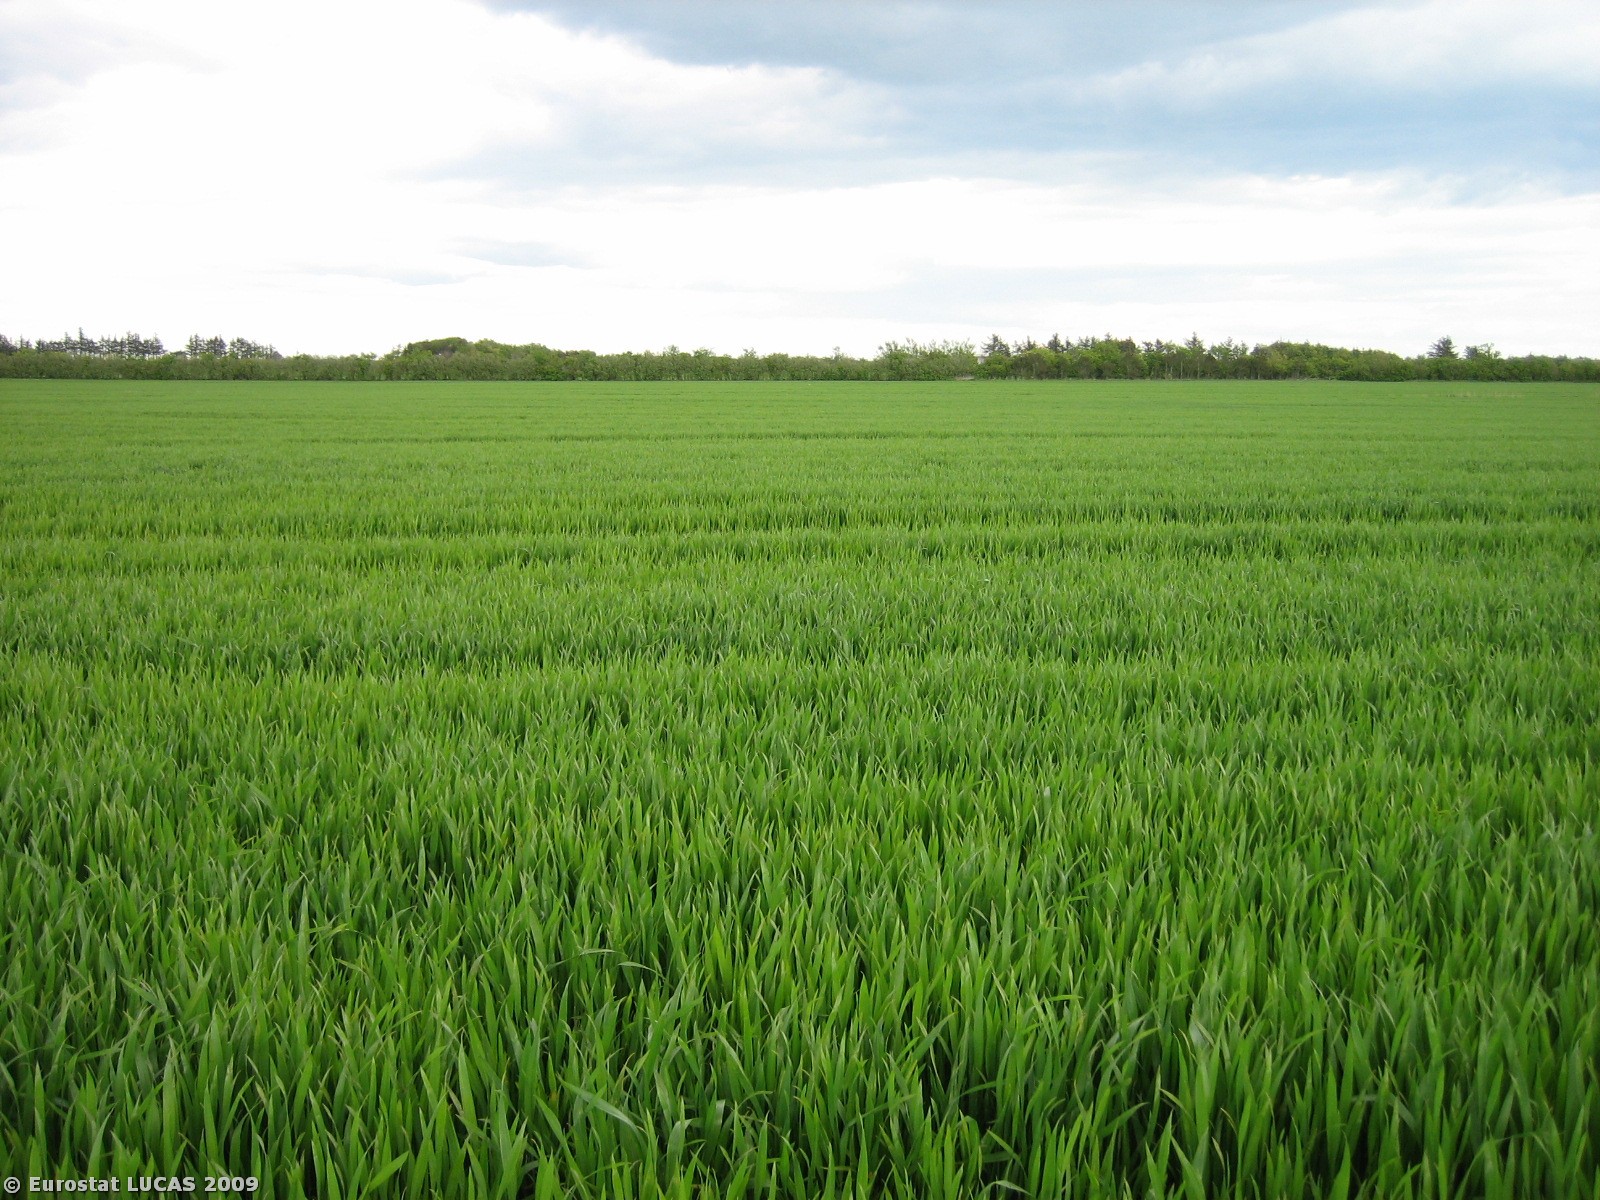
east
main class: Cropland
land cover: Common wheat
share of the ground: > 75 %
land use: Agriculture (excluding fallow land and kitchen gardens)
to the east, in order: Common wheat
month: May
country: DK
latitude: 56.2113
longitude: 8.2123
